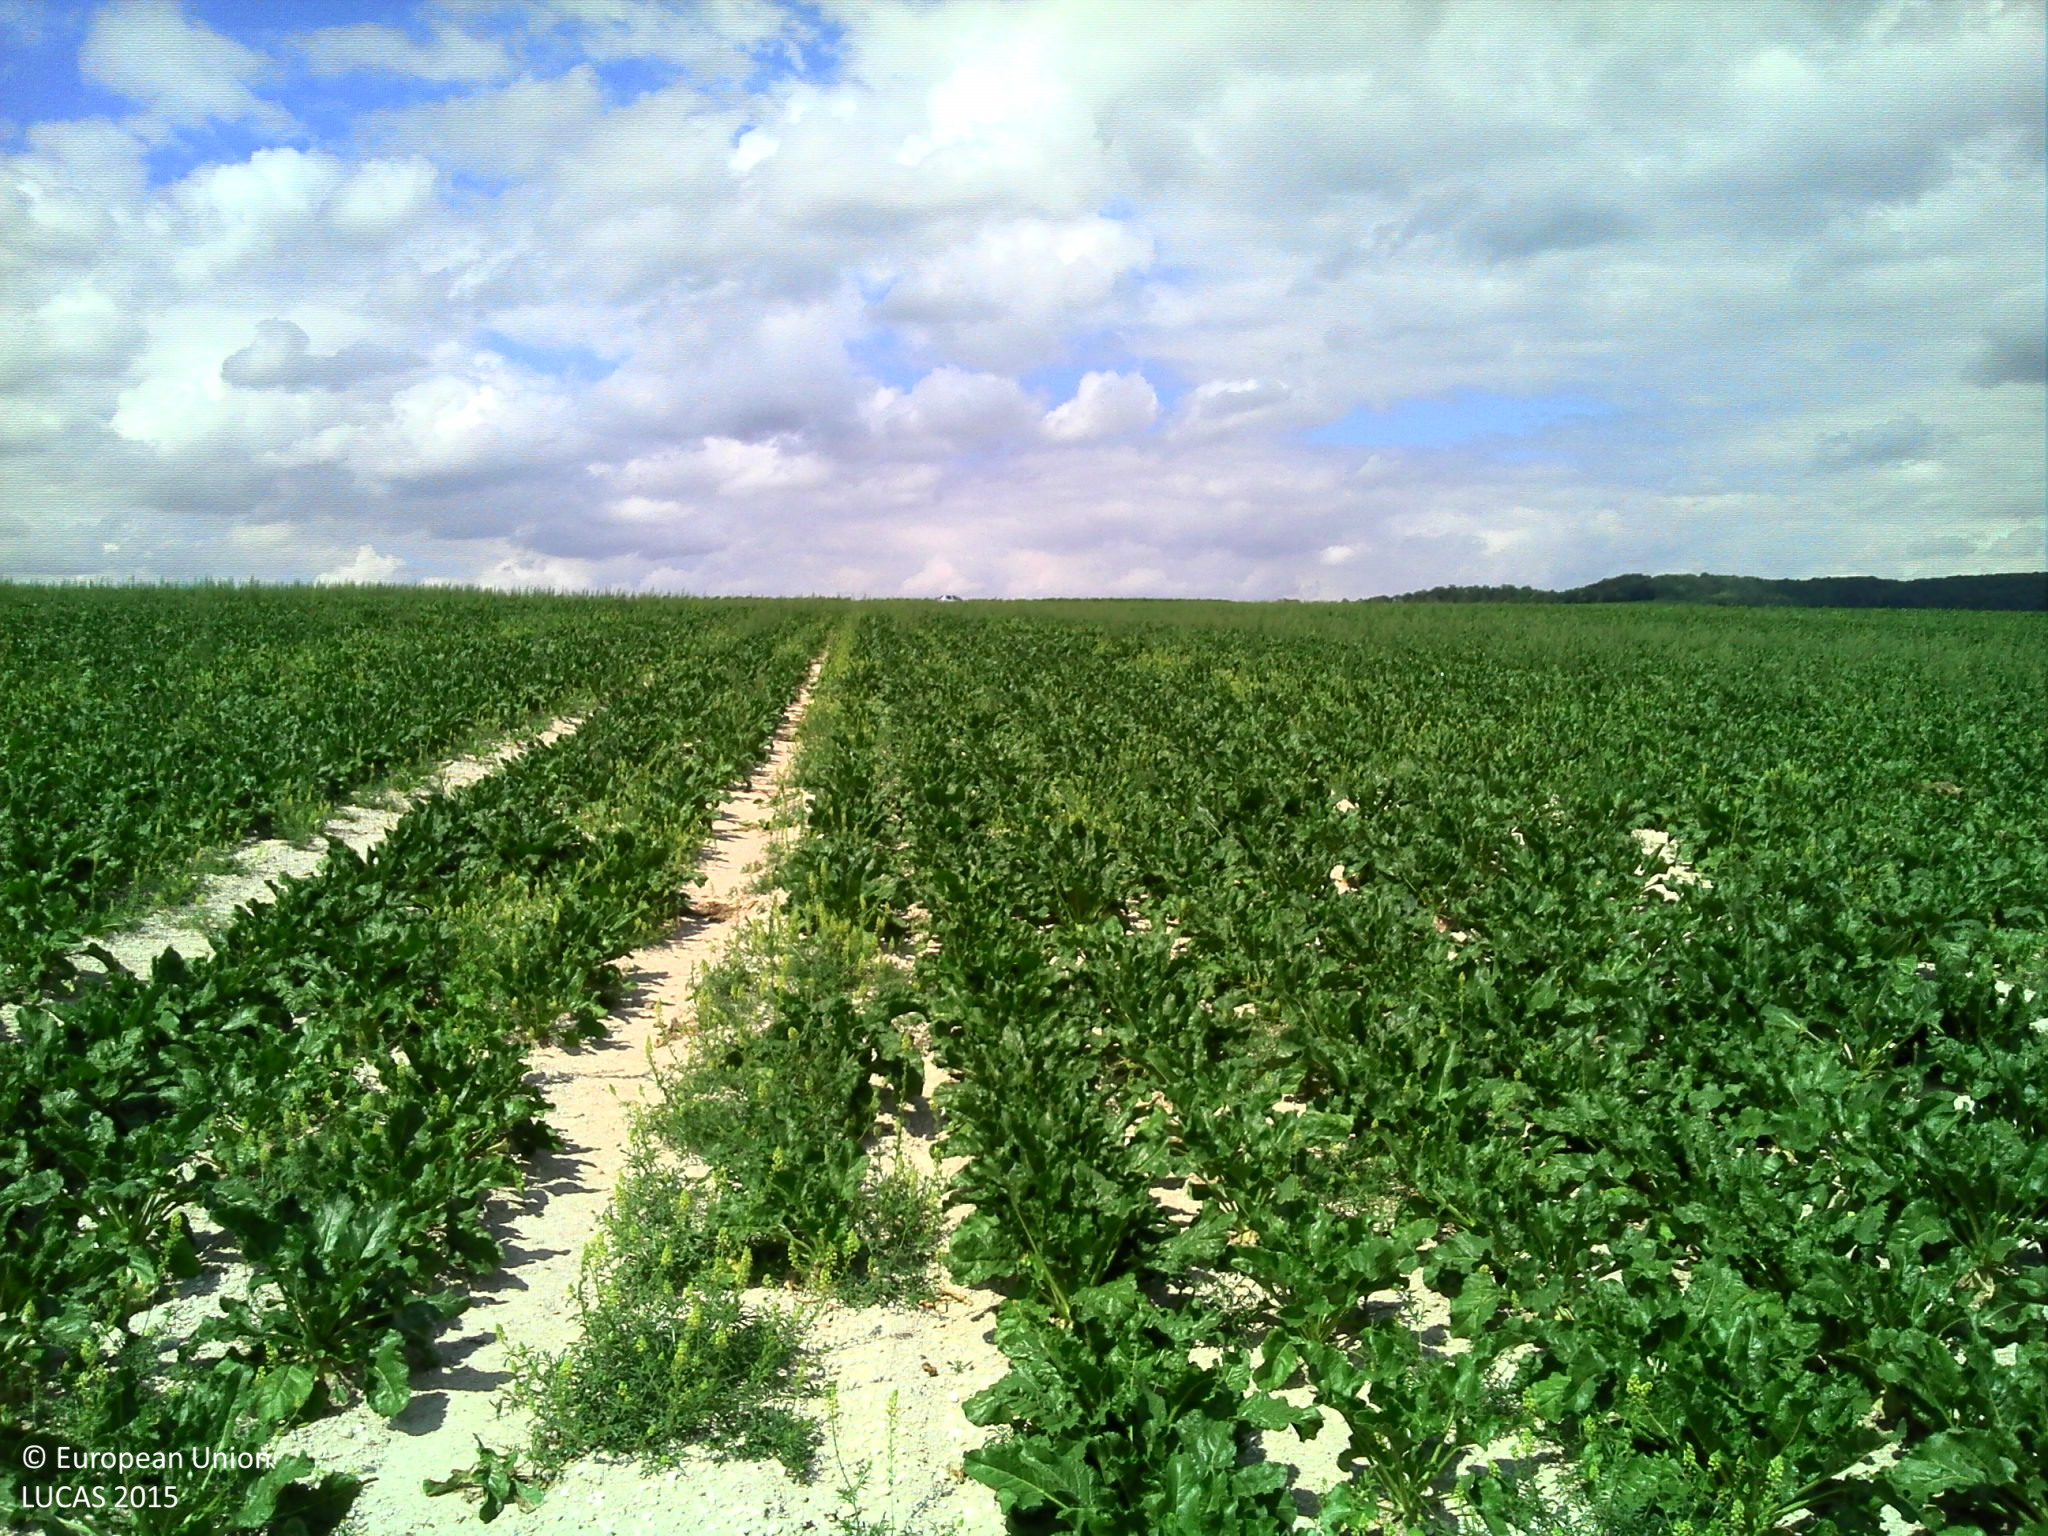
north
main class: Cropland
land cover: Sugar beet
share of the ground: > 75 %
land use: Agriculture (excluding fallow land and kitchen gardens)
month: August
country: FR
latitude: 49.0769
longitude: 4.1225
